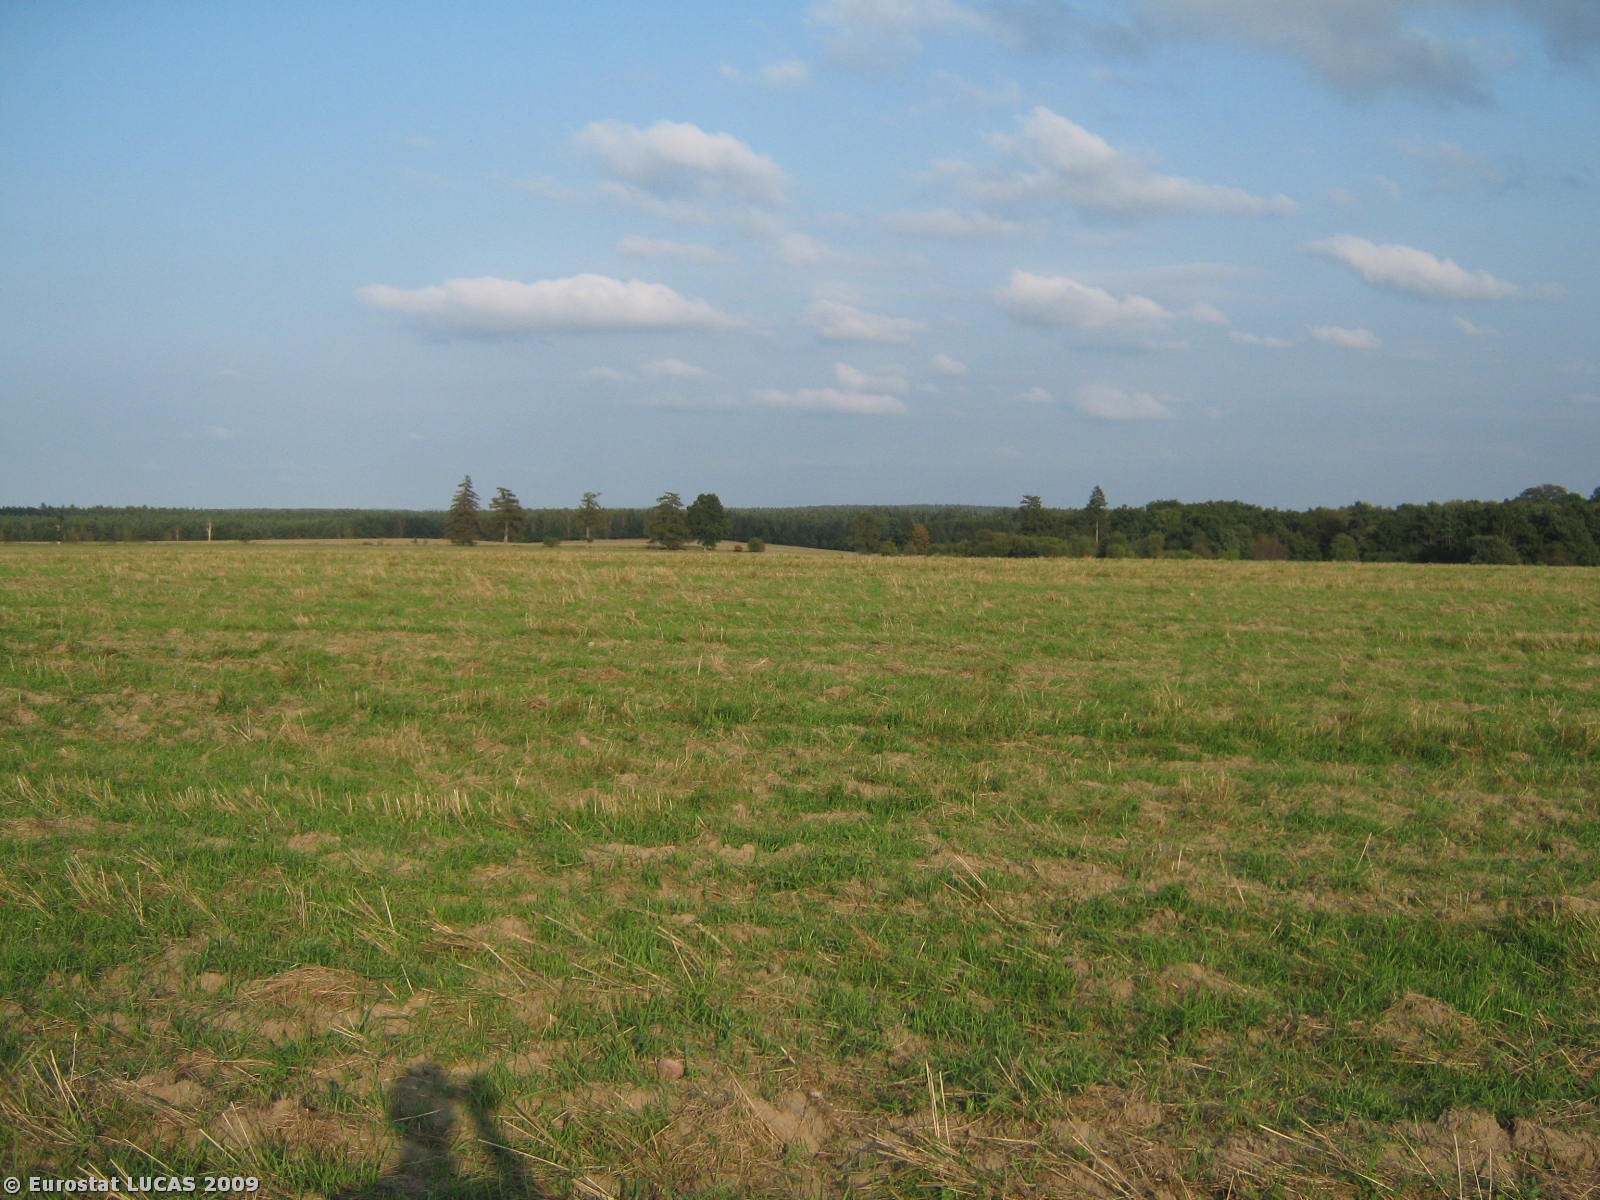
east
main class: Cropland
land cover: Triticale
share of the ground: < 10 %
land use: Agriculture (excluding fallow land and kitchen gardens)
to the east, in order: Triticale
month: September
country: PL
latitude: 53.7934
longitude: 16.3666
